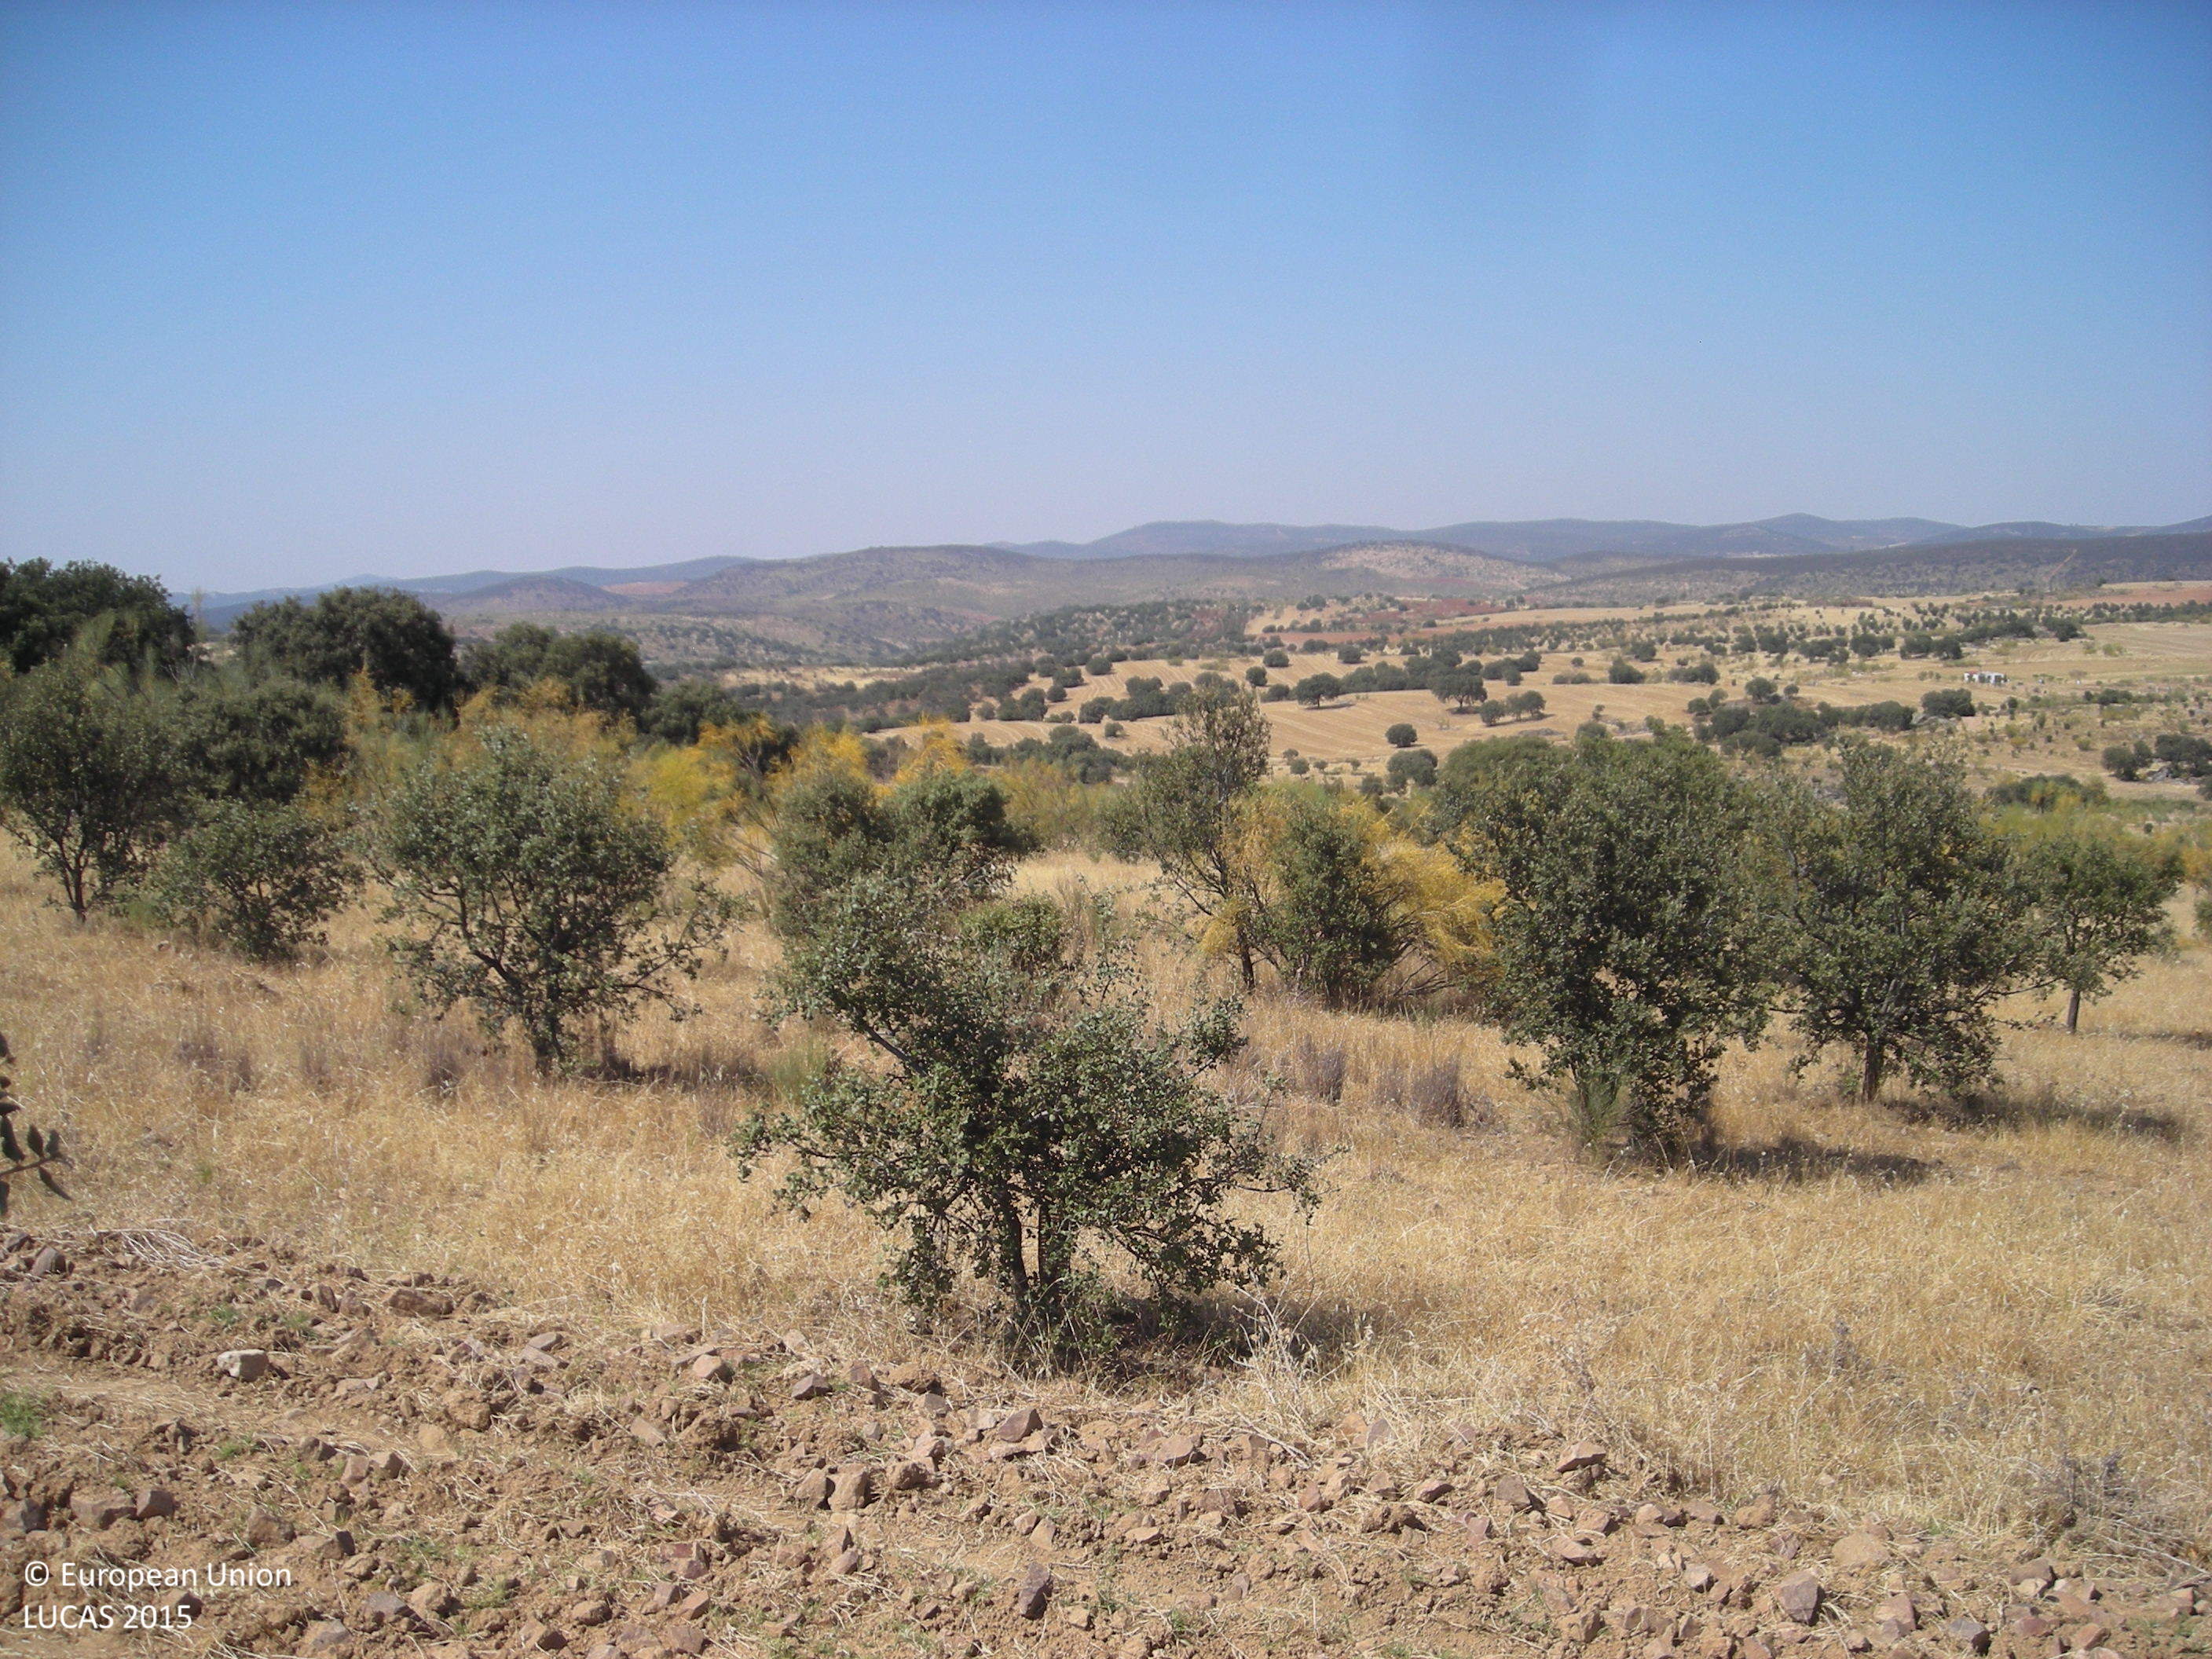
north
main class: Shrubland
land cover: Shrubland without tree cover
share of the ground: > 75 %
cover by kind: shrubs 100 %
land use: Semi-natural and natural areas not in use
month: July
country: ES
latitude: 38.6930
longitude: -5.8533
